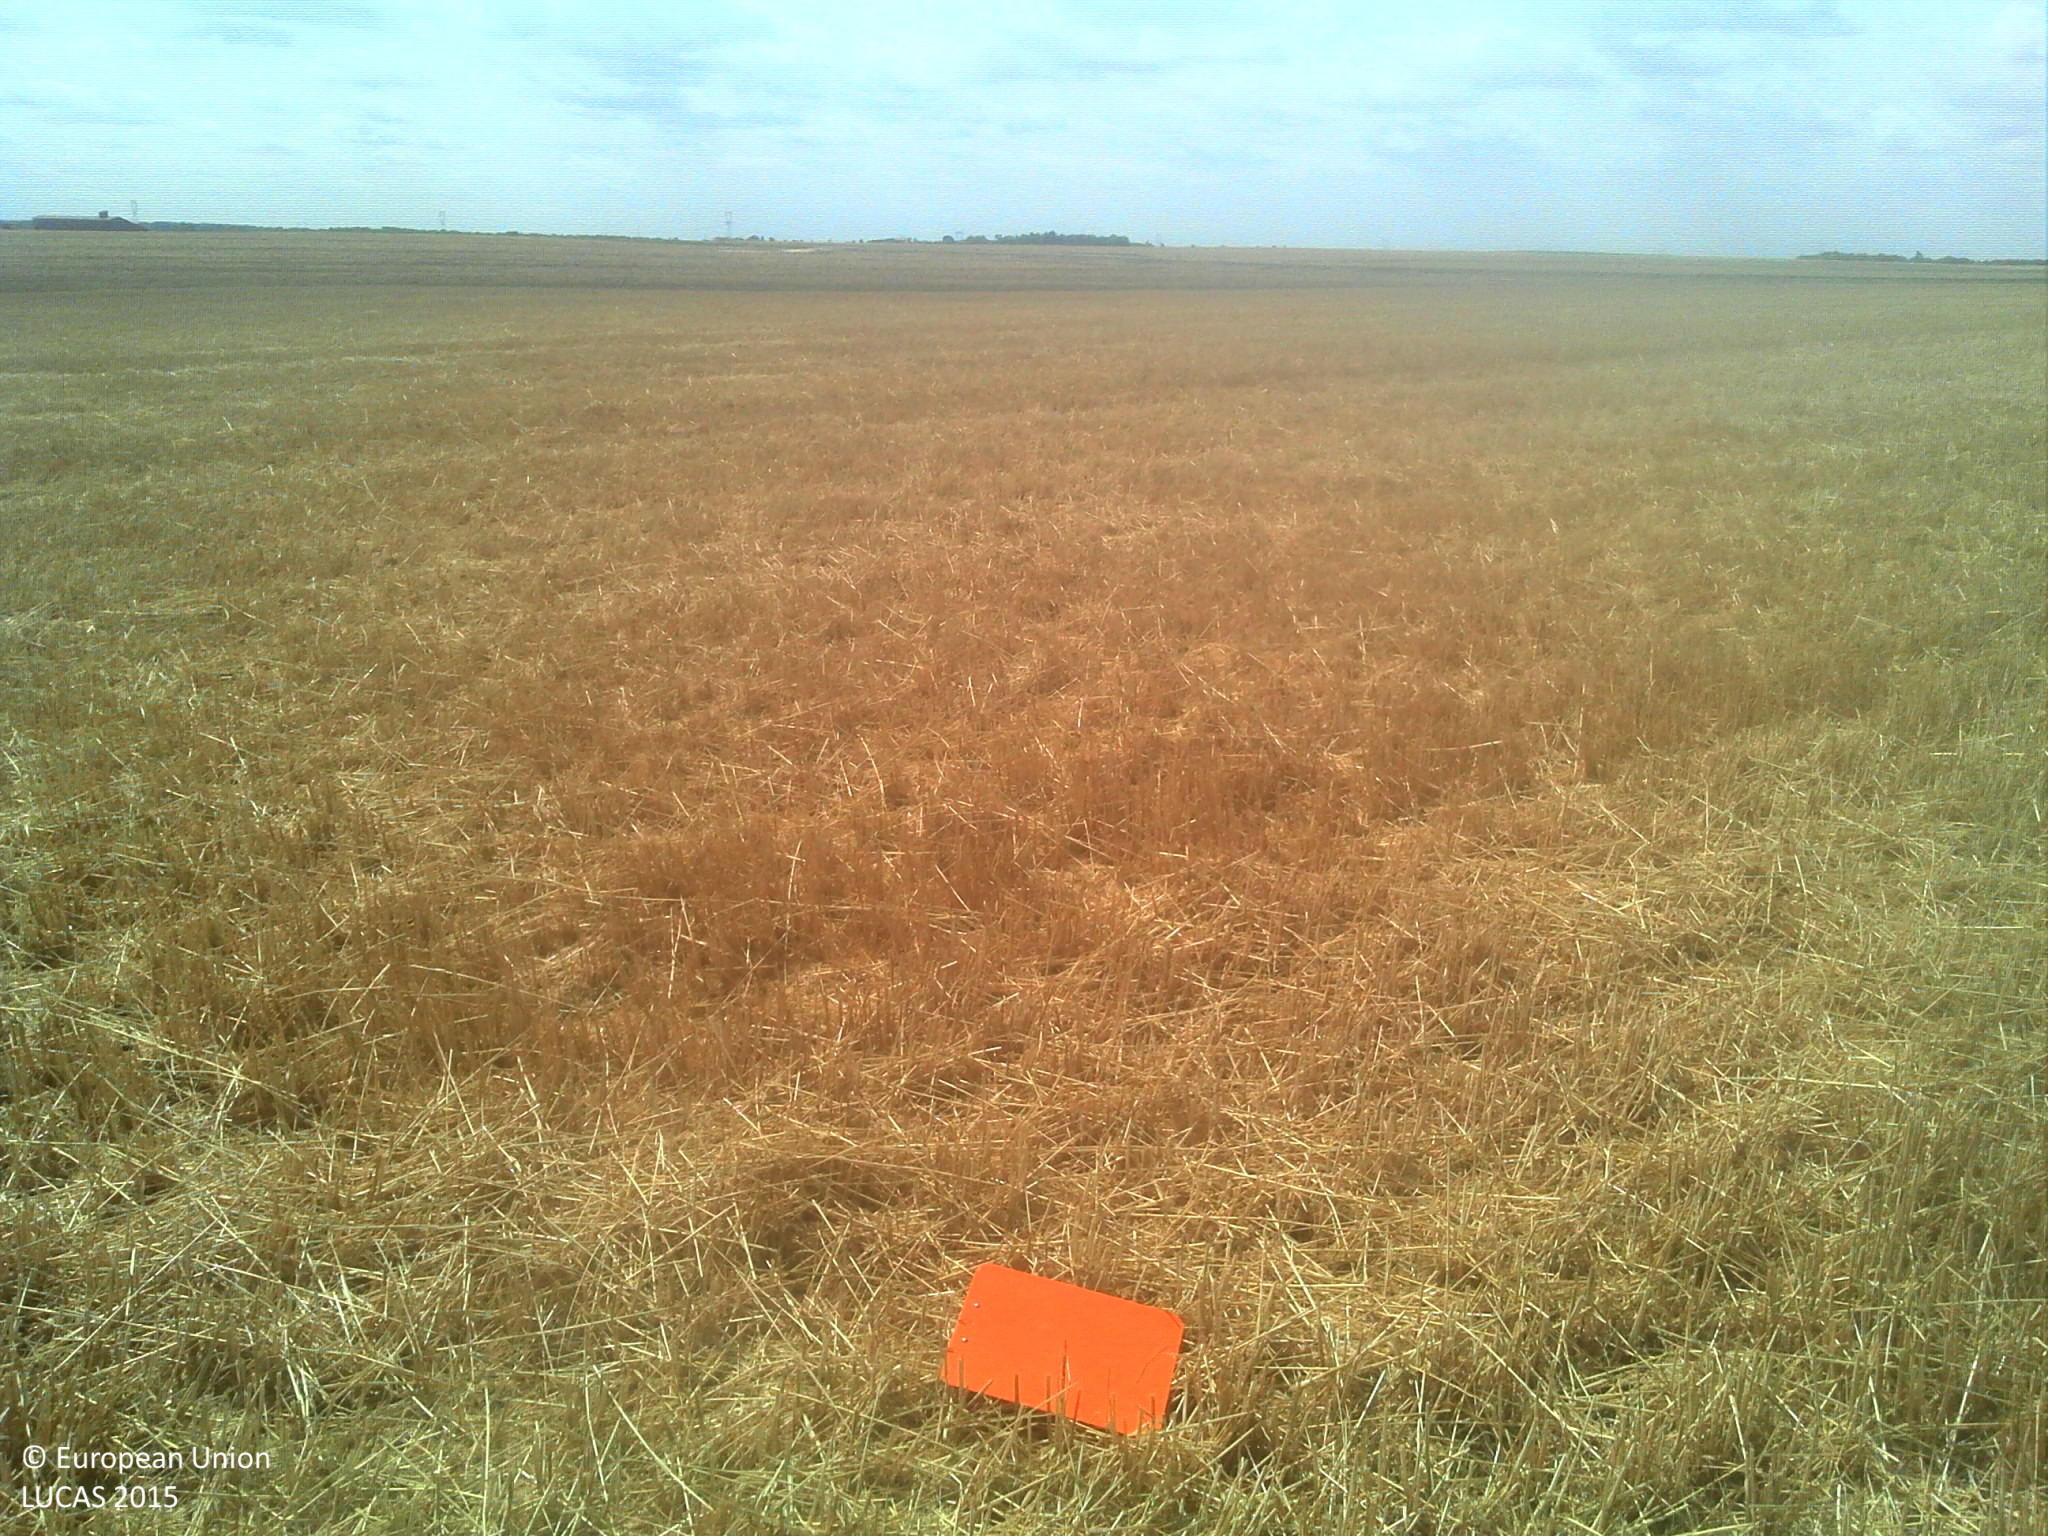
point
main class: Cropland
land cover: Durum wheat
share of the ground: > 75 %
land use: Agriculture (excluding fallow land and kitchen gardens)
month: July
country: FR
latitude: 47.7671
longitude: 1.4858
